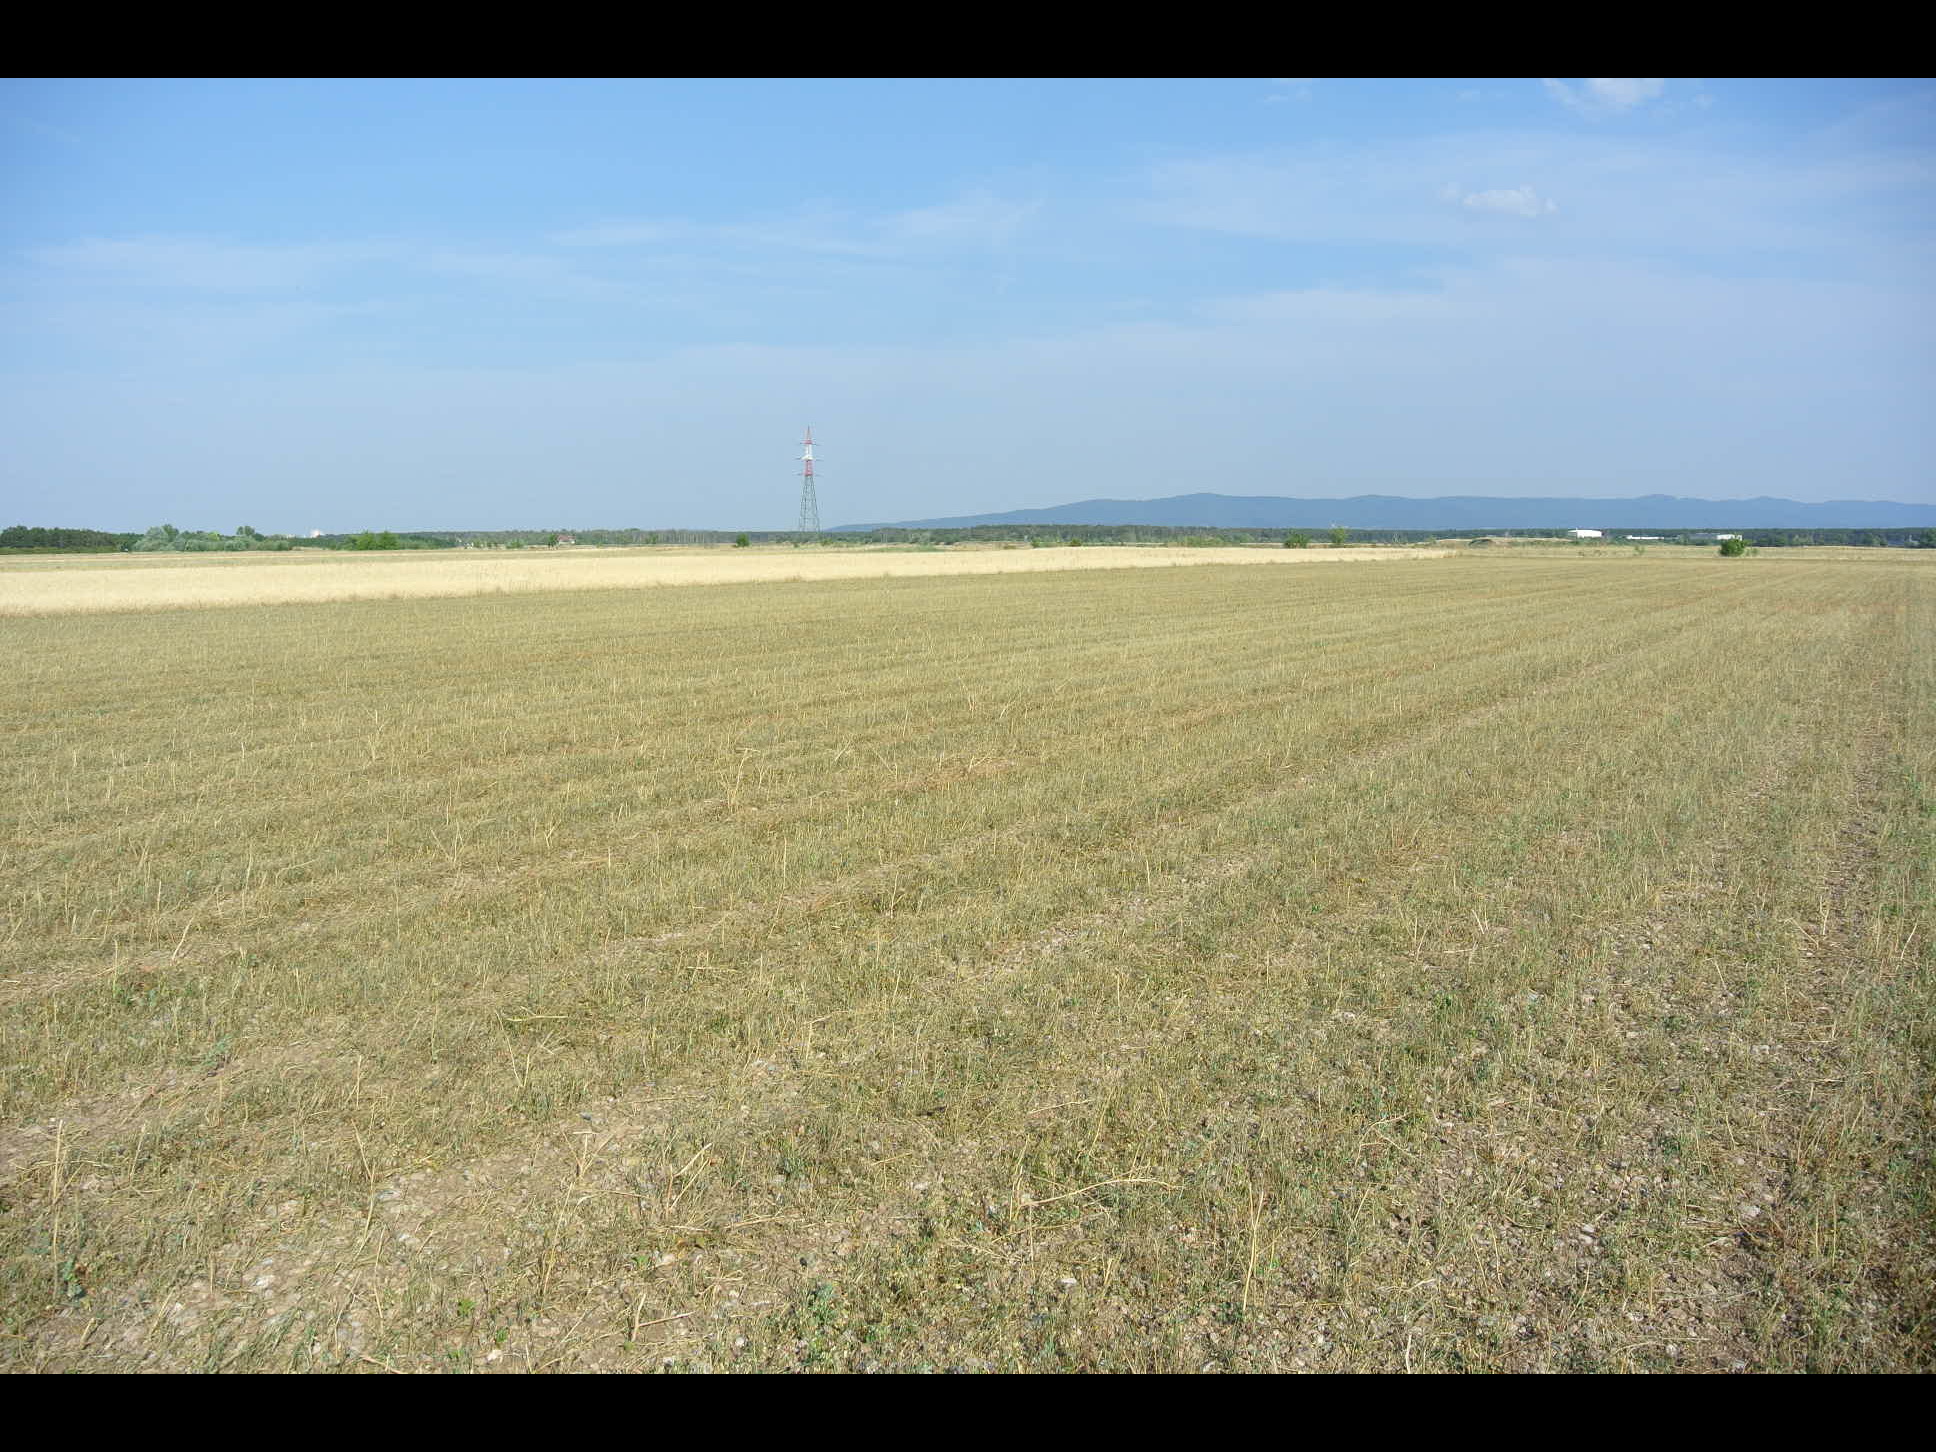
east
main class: Grassland
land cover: Grassland without tree/shrub cover
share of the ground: > 75 %
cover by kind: herbaceous plants 80 %, unconsolidated bare surface 20 %
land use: Agriculture (excluding fallow land and kitchen gardens)
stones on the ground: > 50 %
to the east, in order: Grassland without tree/shrub cover; Common wheat; Spontaneously vegetated surfaces; Dry pulses; Spontaneously vegetated surfaces; Common wheat; Other bare soil; Spontaneously vegetated surfaces
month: July
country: AT
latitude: 47.8166
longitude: 16.1603
